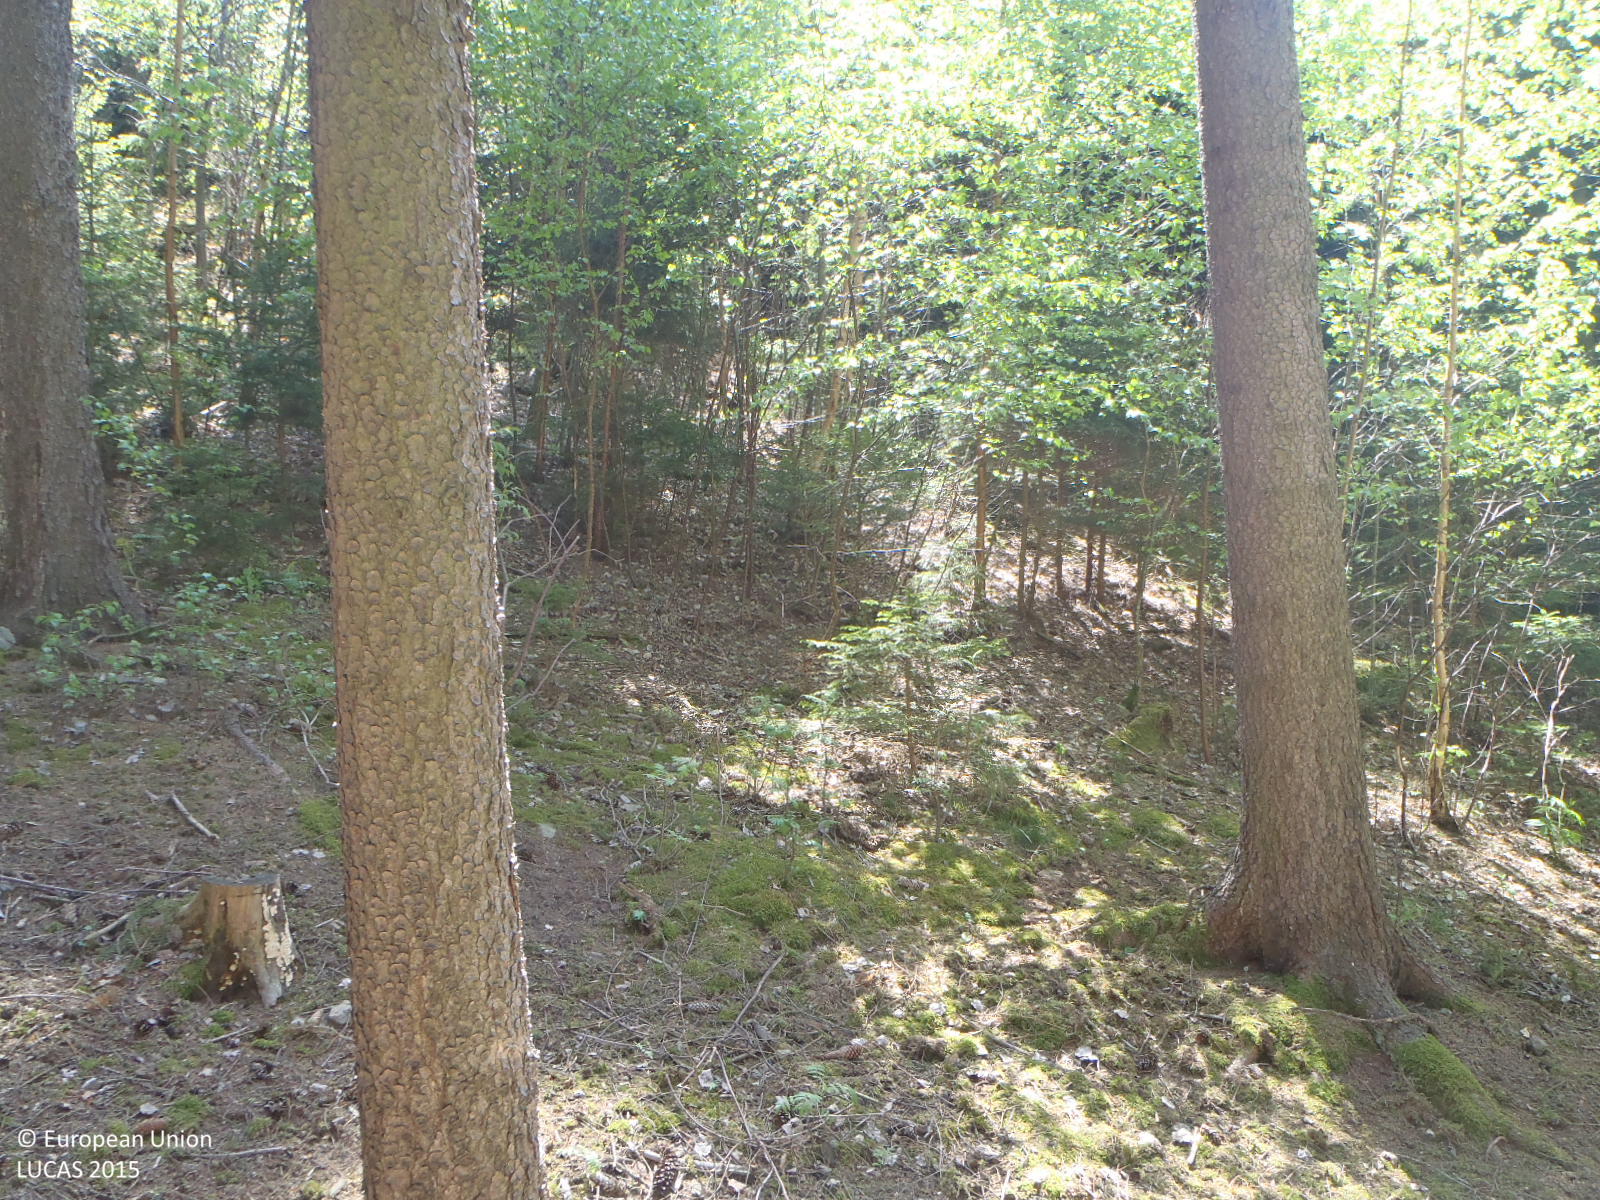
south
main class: Woodland
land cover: Spruce dominated coniferous woodland
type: hemiboreal forest and nemoral coniferous forest and mixed broadleaved-coniferous forest
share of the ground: > 75 %
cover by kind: coniferous forest trees 85 %, broadleaved forest trees 5 %, lichens and mosses 5 %, unconsolidated bare surface 5 %
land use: Forestry
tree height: > 5 m
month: May
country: CZ
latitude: 49.1515
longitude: 15.4739
